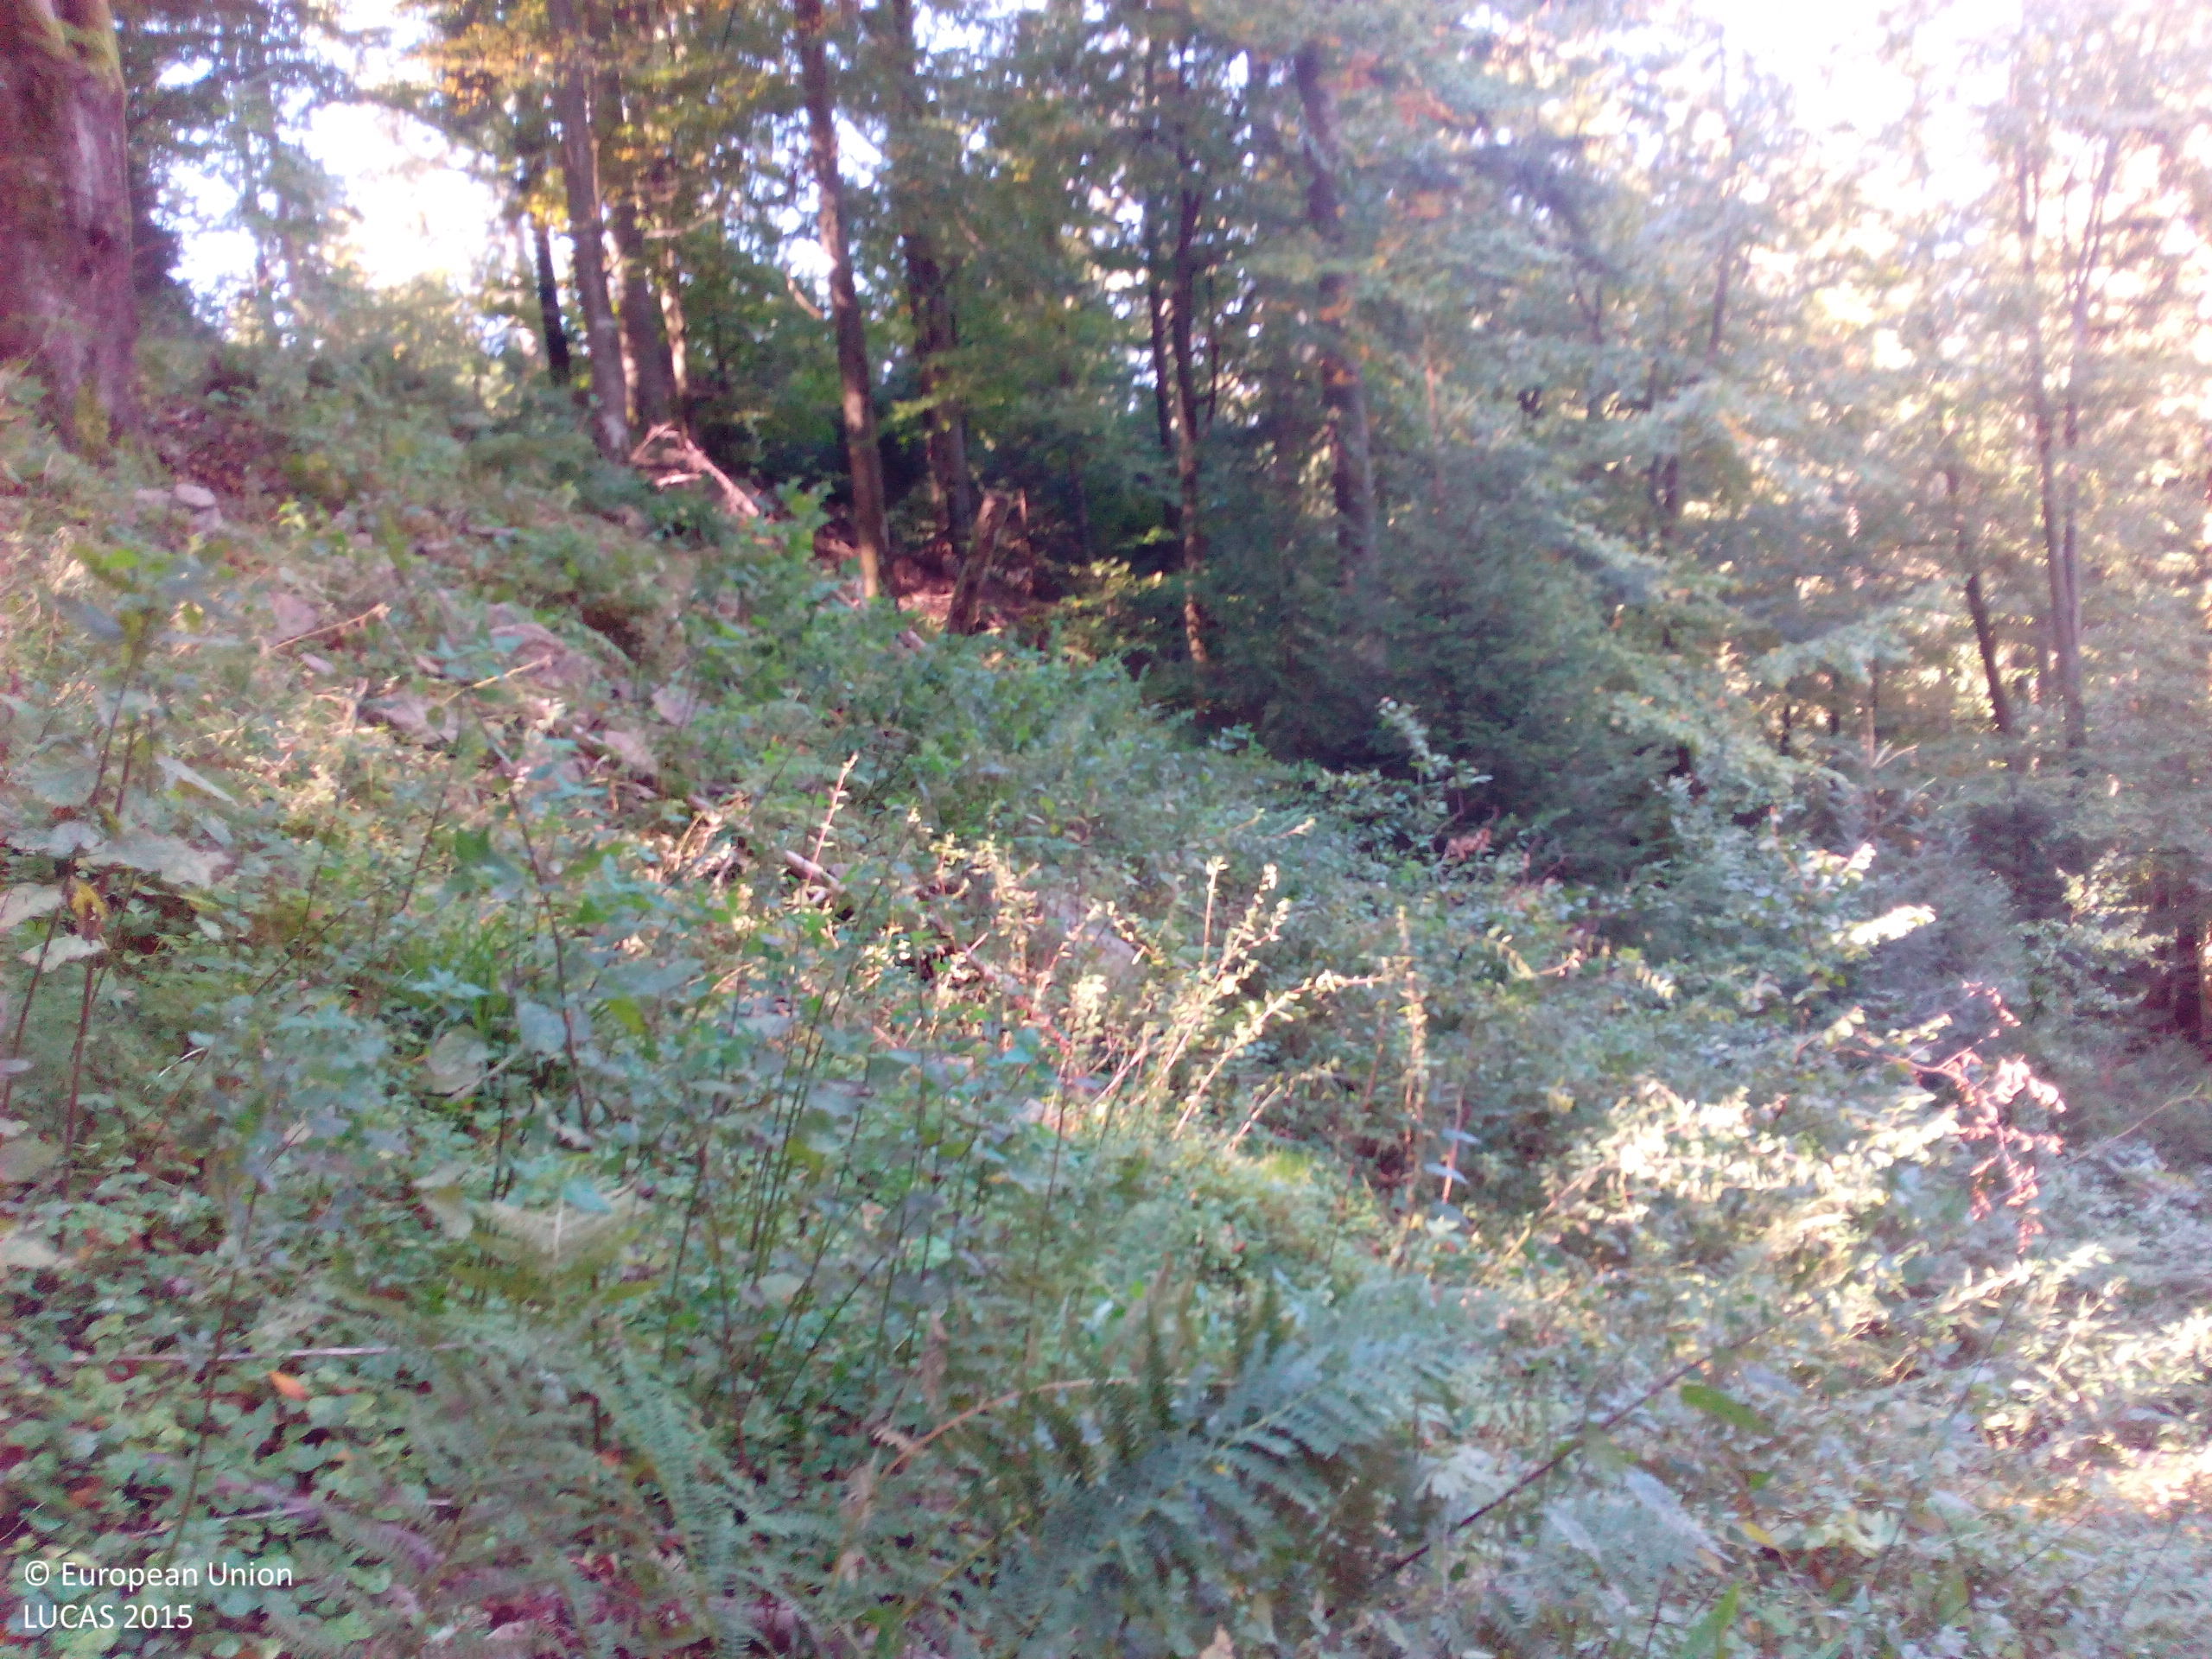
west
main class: Woodland
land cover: Other mixed woodland
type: hemiboreal forest and nemoral coniferous forest and mixed broadleaved-coniferous forest
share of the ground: 50 - 75 %
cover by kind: broadleaved forest trees 40 %, coniferous forest trees 30 %, shrubs 20 %, herbaceous plants 10 %
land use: Forestry
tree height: > 5 m
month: September
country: DE
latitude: 48.6228
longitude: 8.1964
